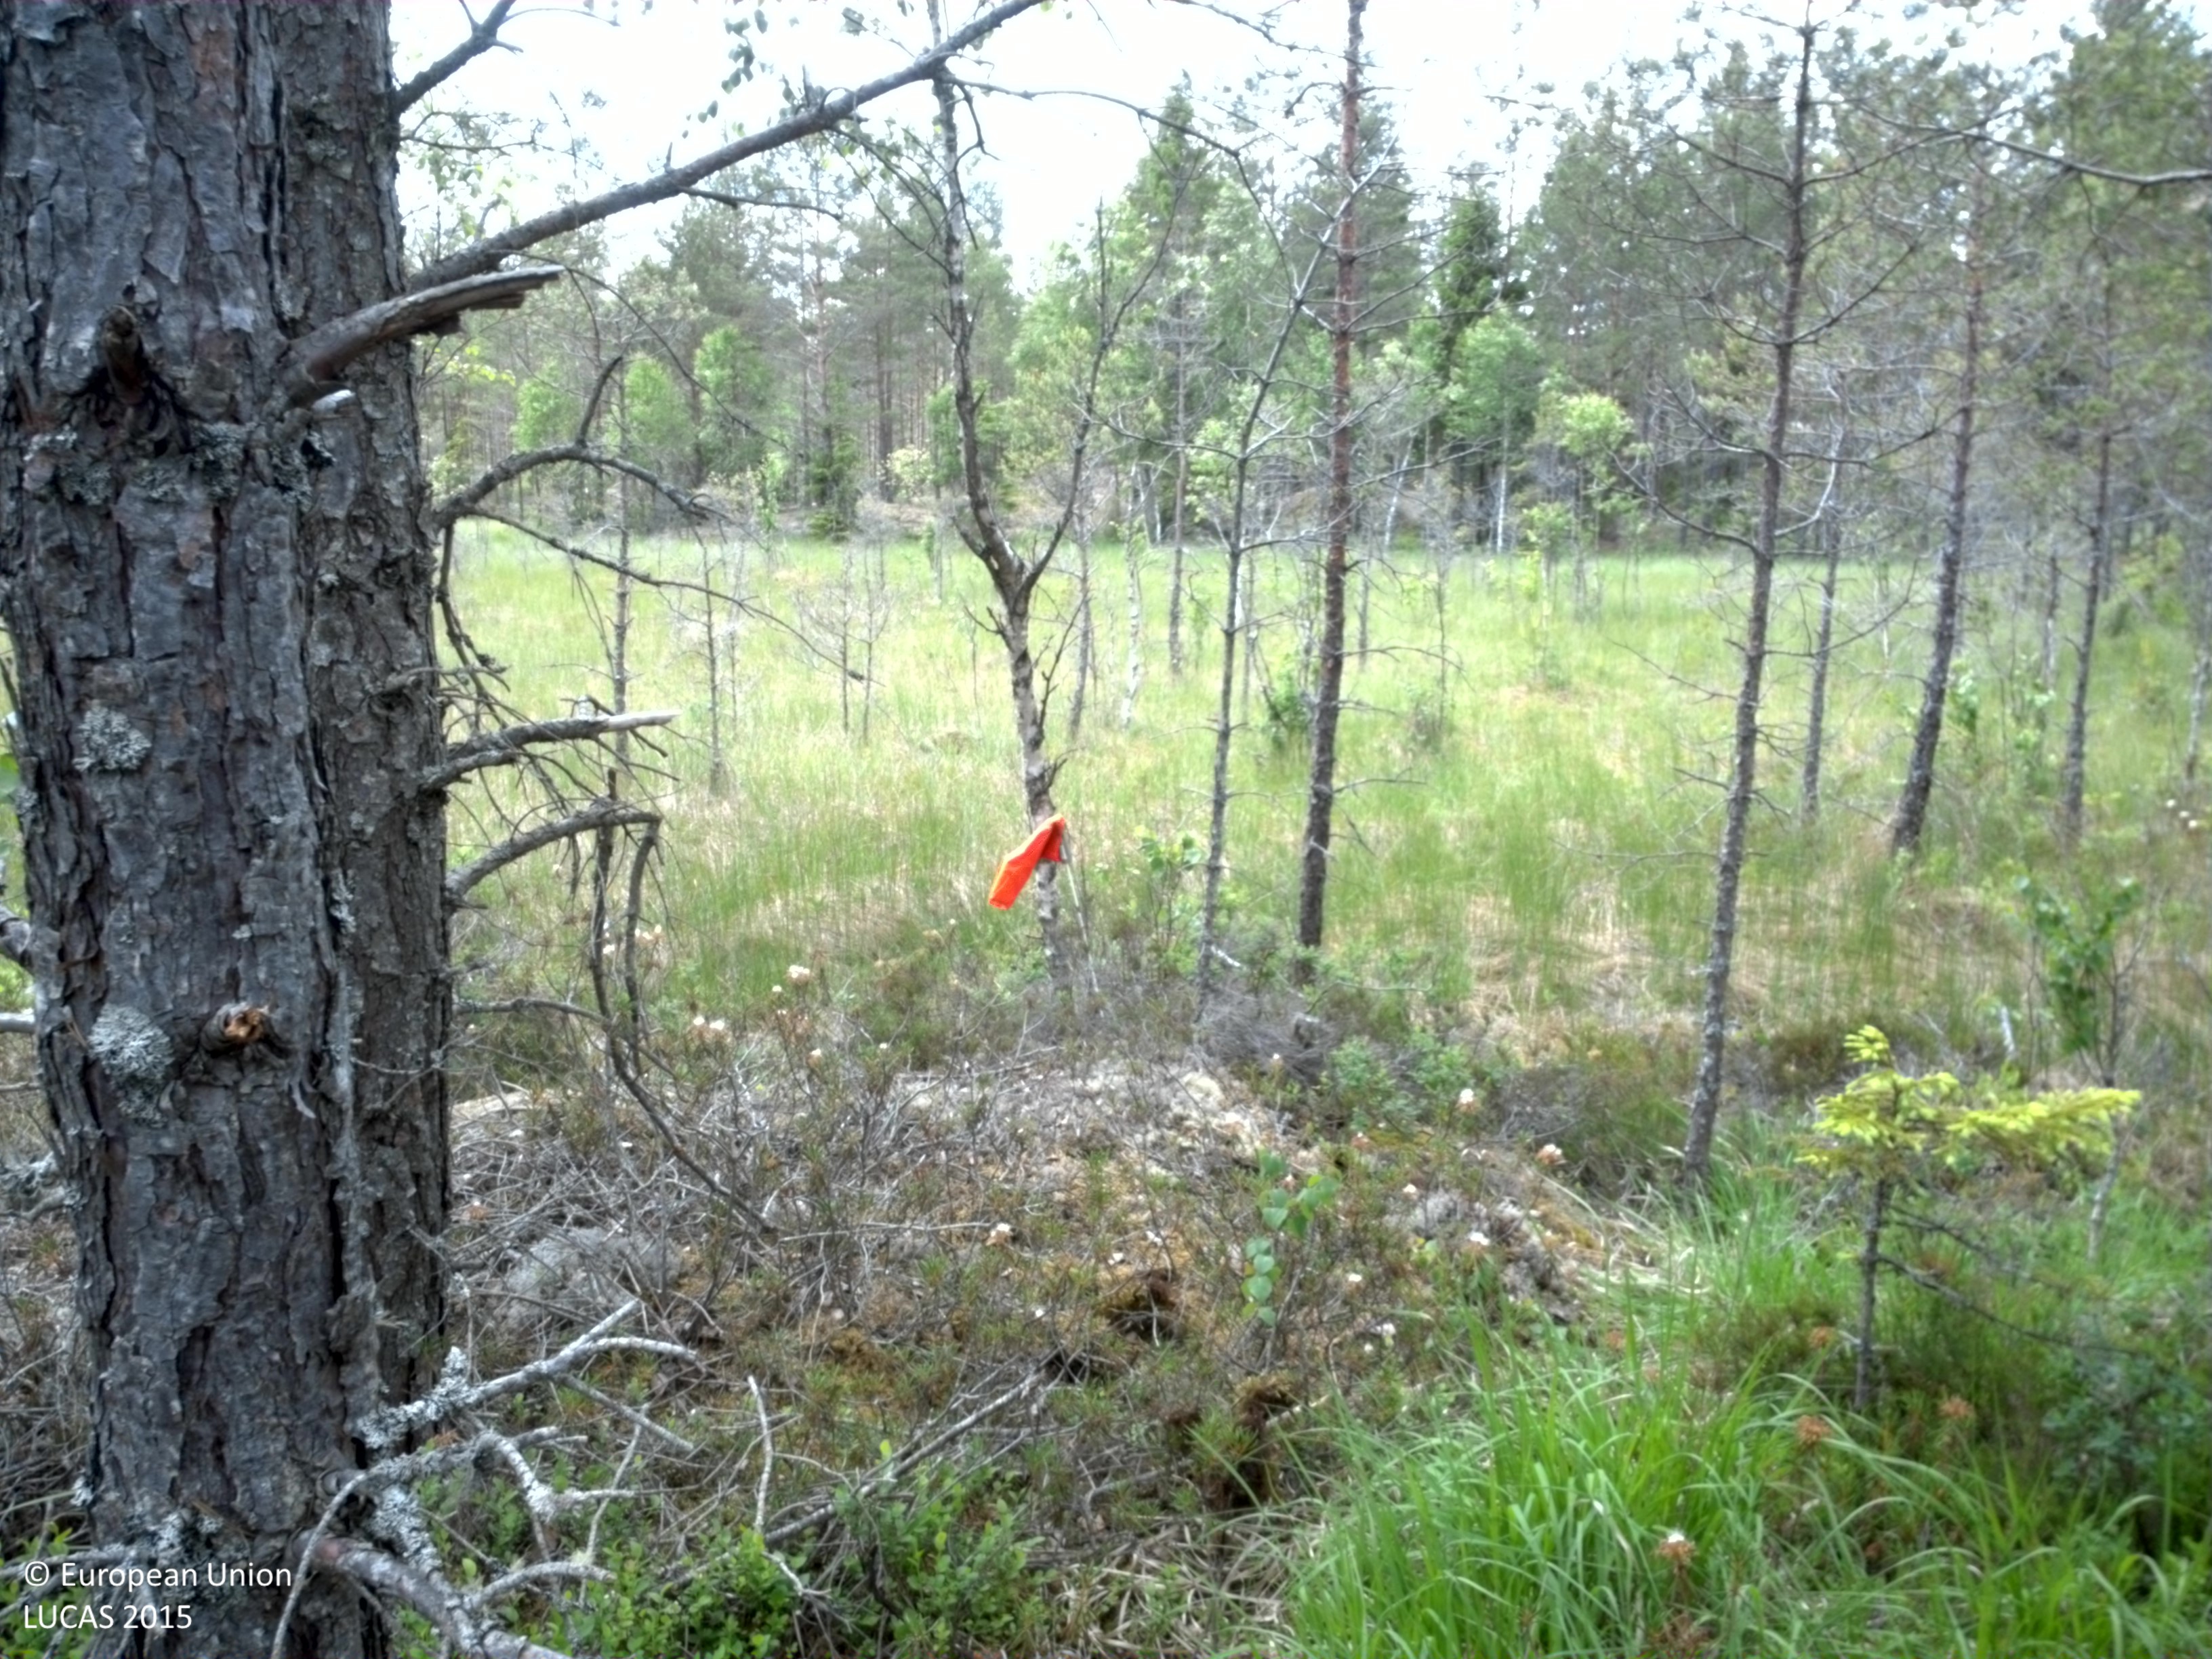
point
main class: Woodland
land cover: Pine dominated mixed woodland
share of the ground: 25 - 50 %
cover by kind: herbaceous plants 30 %, lichens and mosses 30 %, coniferous forest trees 20 %, broadleaved forest trees 10 %, shrubs 10 %
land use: Semi-natural and natural areas not in use
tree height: < 5 m
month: June
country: SE
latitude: 58.6636
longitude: 15.5621
